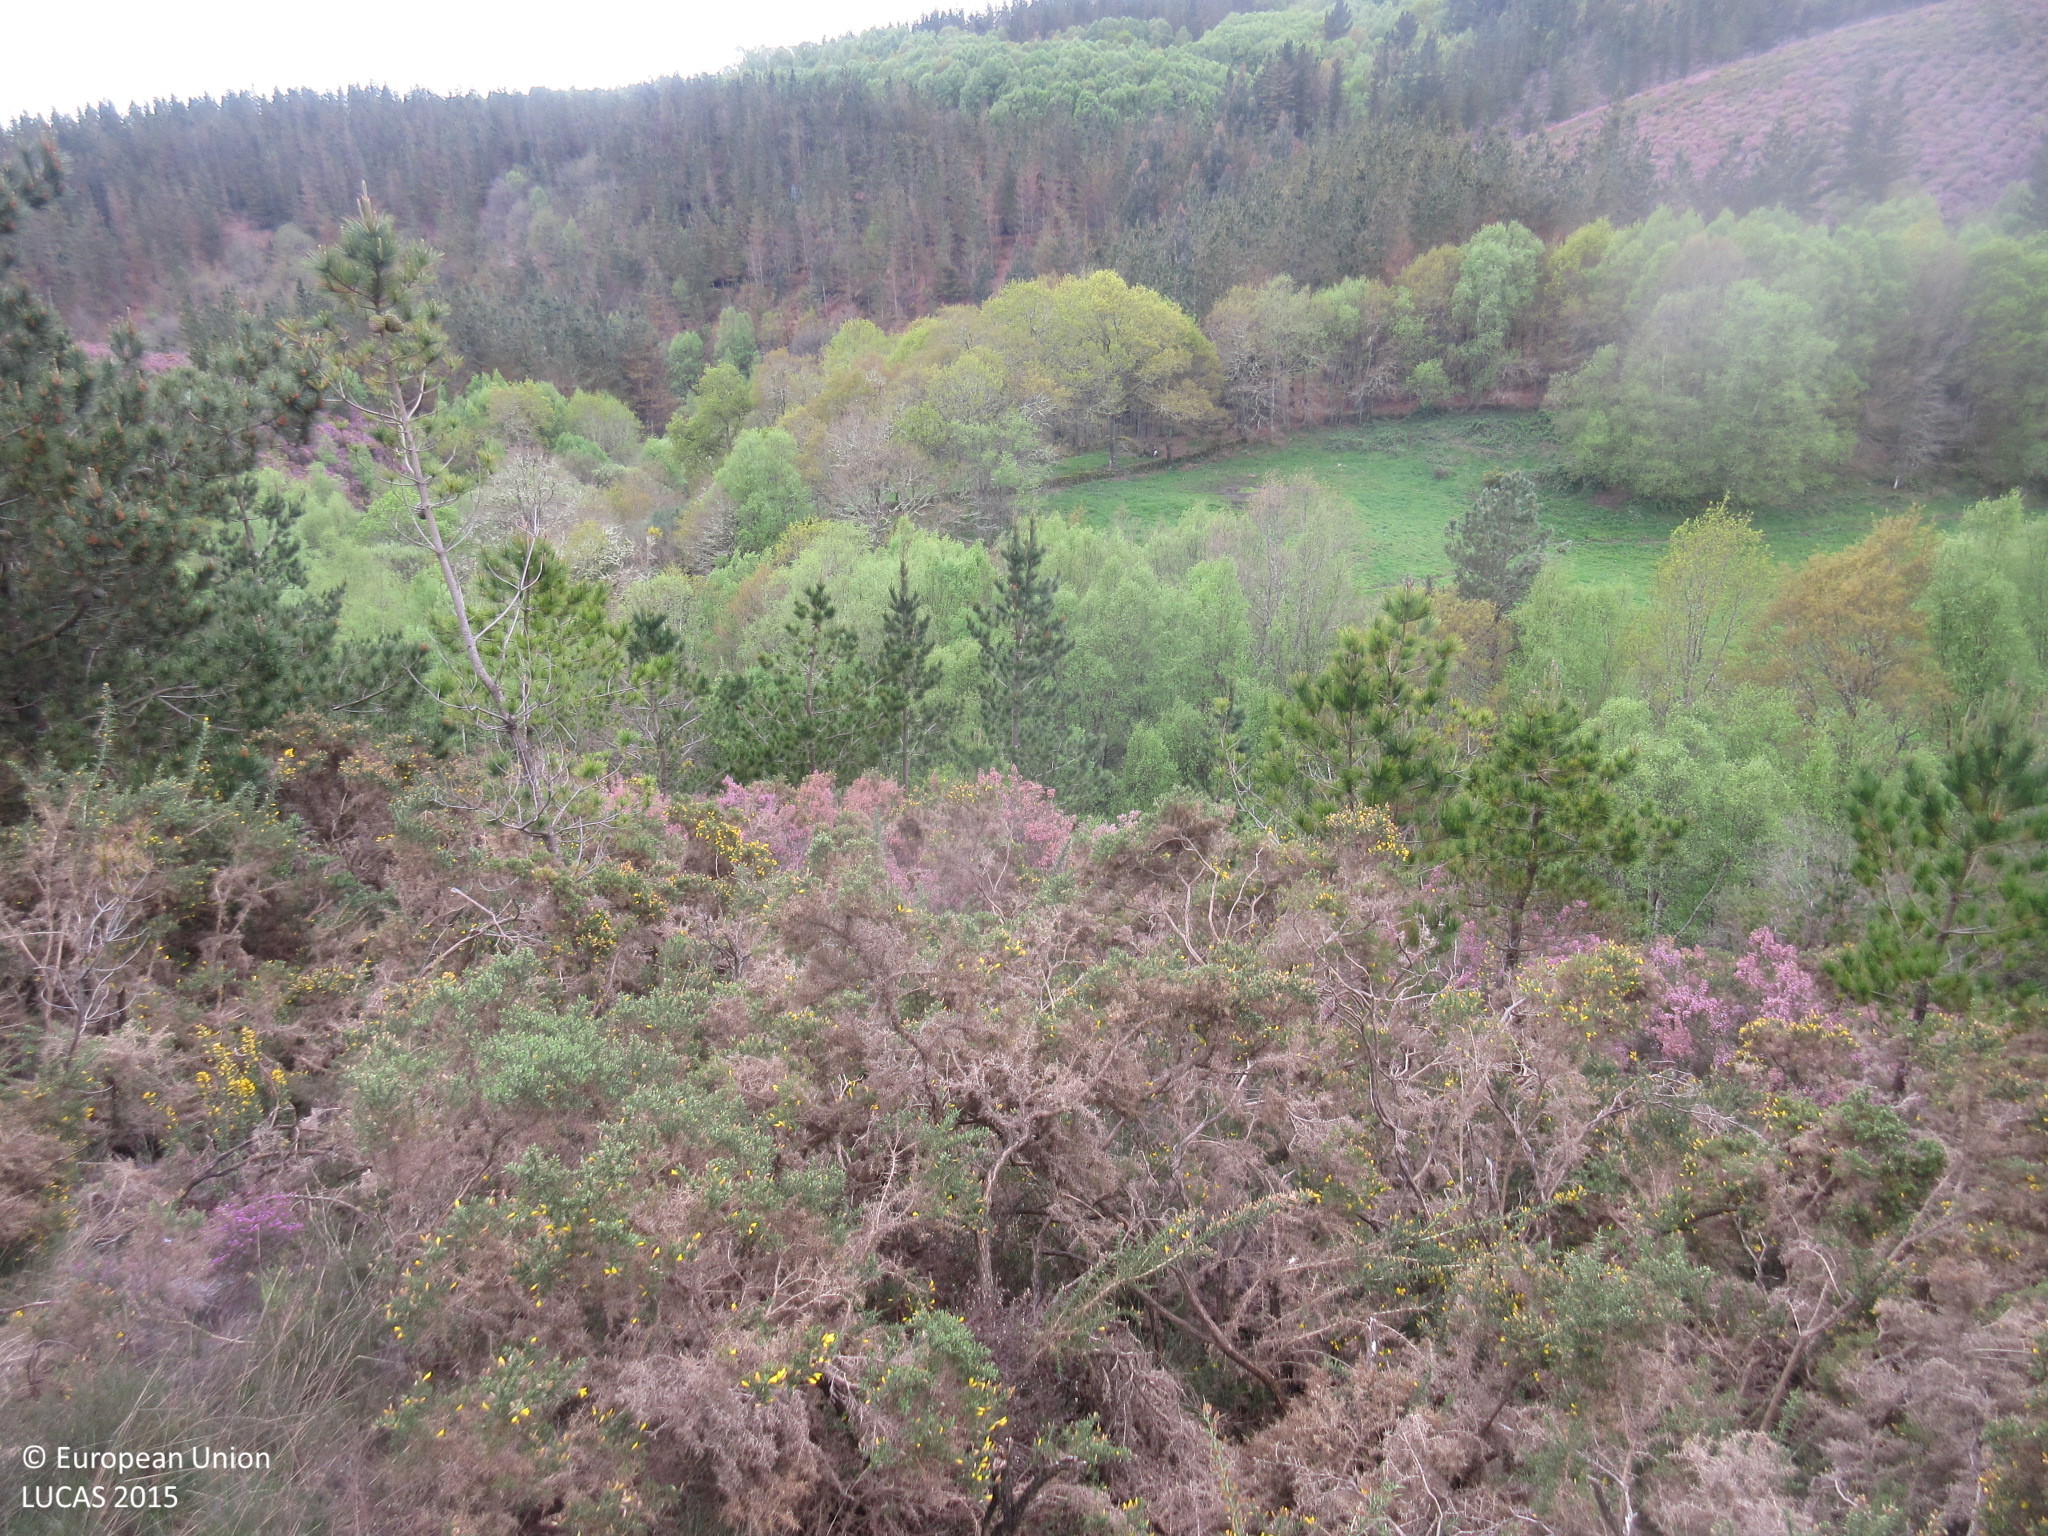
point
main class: Woodland
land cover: Broadleaved woodland
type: acidophilous oak and oak-birch forest
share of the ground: > 75 %
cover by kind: broadleaved forest trees 100 %
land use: Semi-natural and natural areas not in use
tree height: > 5 m
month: April
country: ES
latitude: 43.2562
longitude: -6.9519
